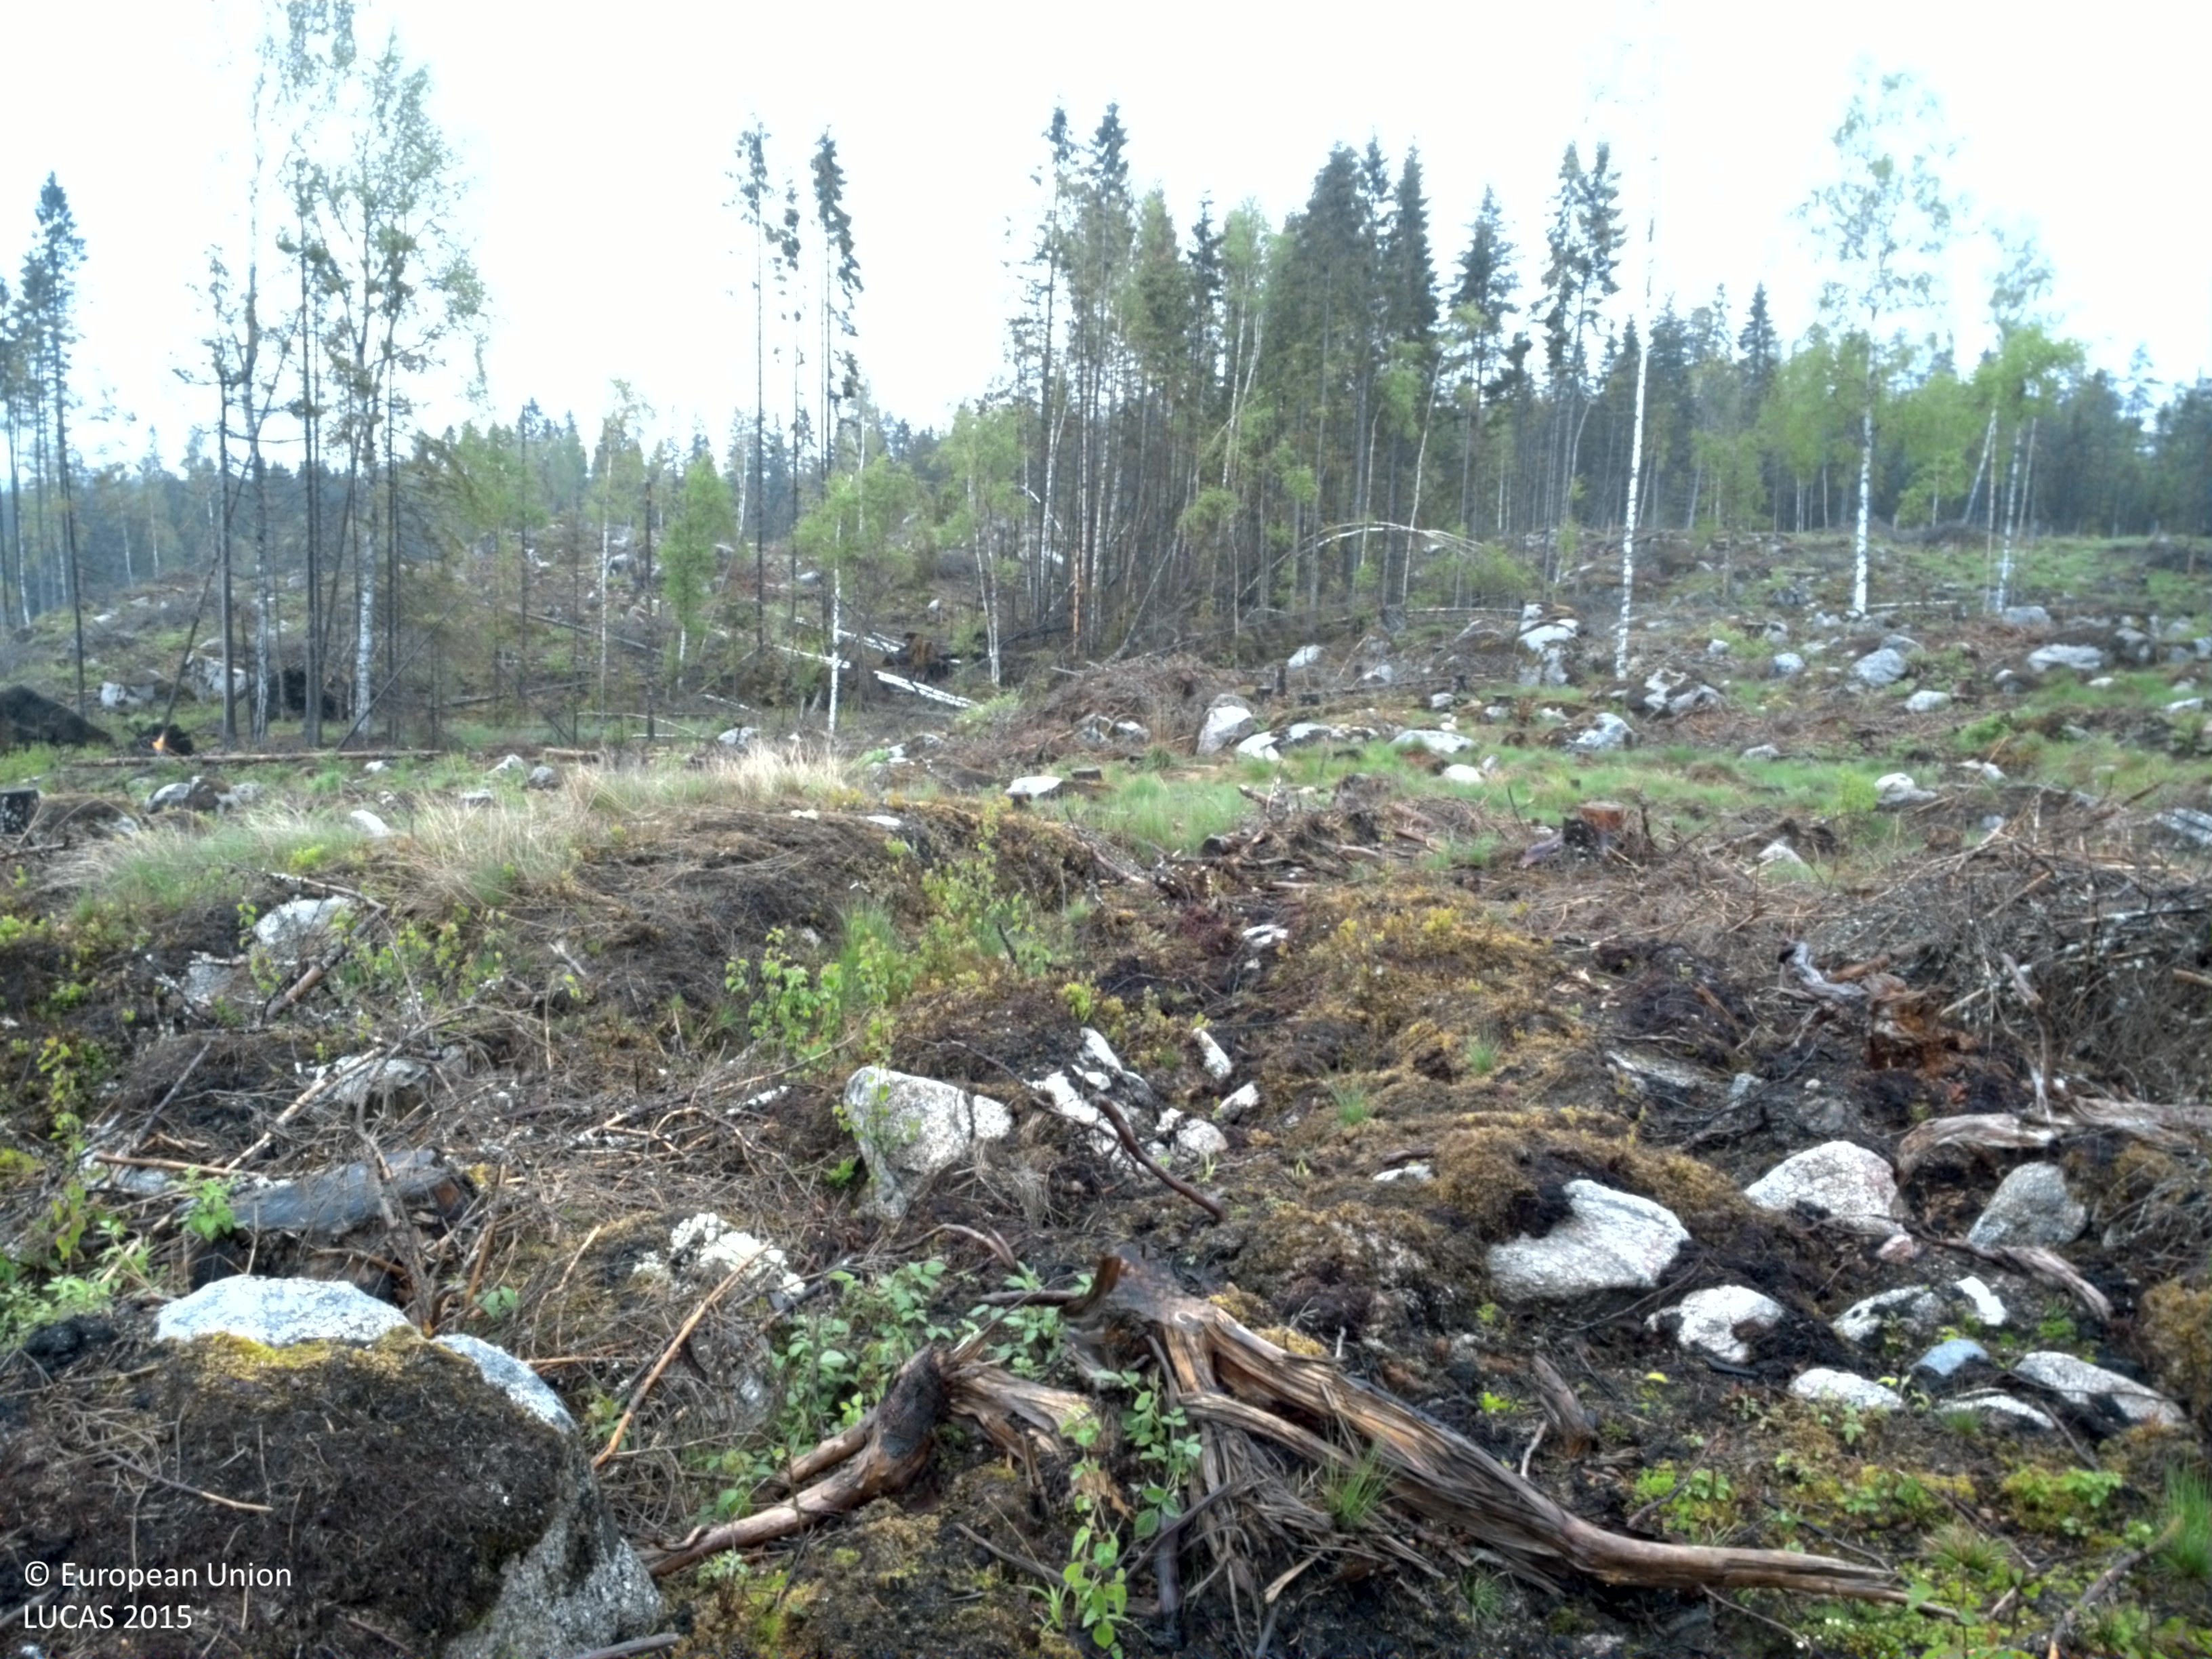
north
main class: Woodland
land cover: Broadleaved woodland
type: boreal forest
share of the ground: 10 - 25 %
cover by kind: shrubs 35 %, herbaceous plants 35 %, broadleaved forest trees 10 %, lichens and mosses 10 %, consolidated bare surface 10 %
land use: Forestry
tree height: < 5 m
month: May
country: SE
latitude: 59.4521
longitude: 14.1718
